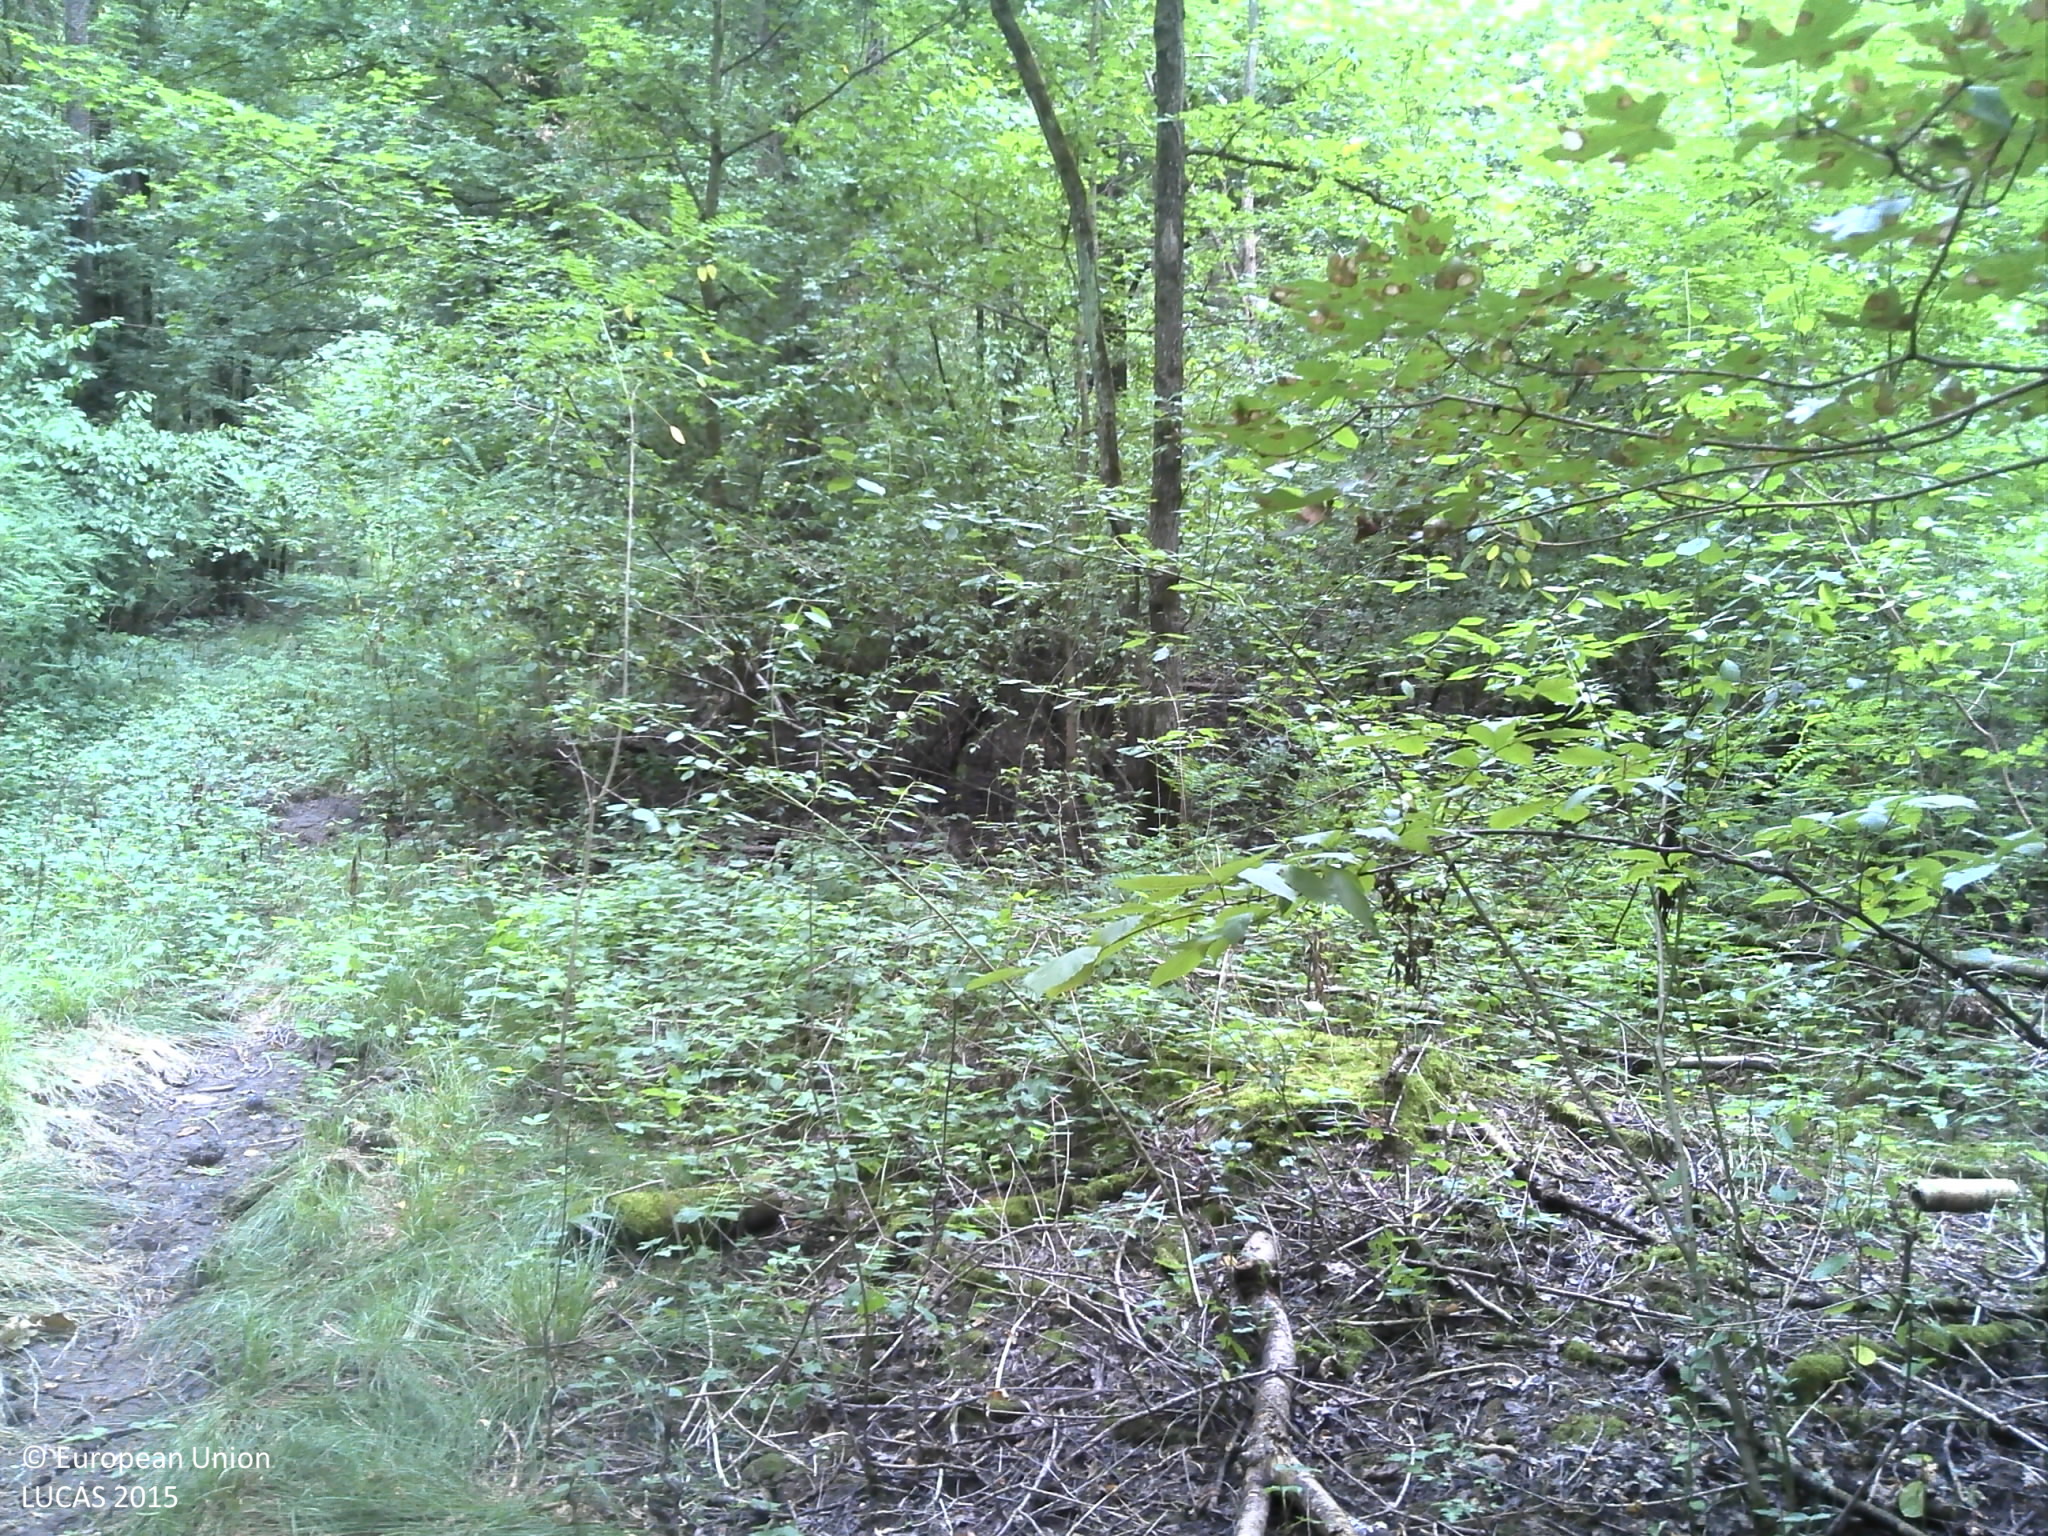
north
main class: Woodland
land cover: Broadleaved woodland
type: mesophytic deciduous forest
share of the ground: > 75 %
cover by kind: broadleaved forest trees 100 %
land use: Forestry
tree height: > 5 m
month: July
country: HR
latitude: 44.9359
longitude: 18.8125
